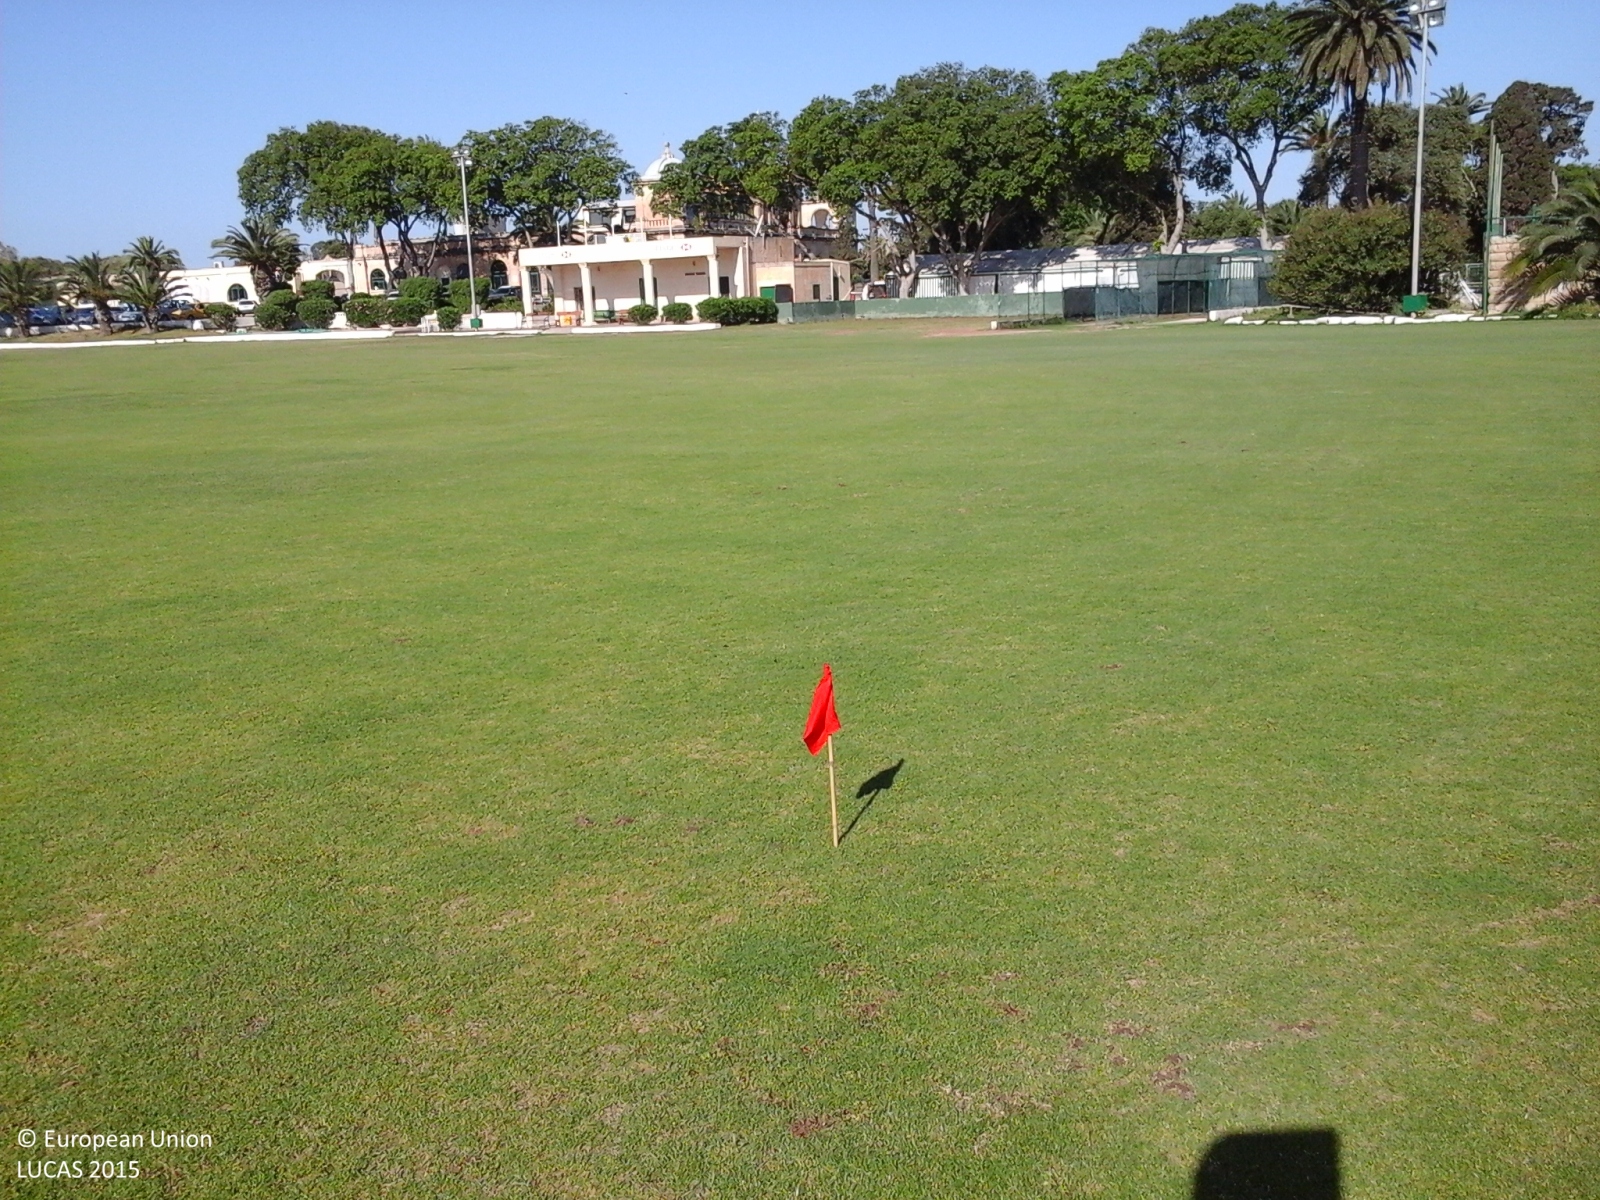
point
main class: Grassland
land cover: Grassland without tree/shrub cover
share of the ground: > 75 %
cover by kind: herbaceous plants 100 %
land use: Sport
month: May
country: MT
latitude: 35.8763
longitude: 14.4886
